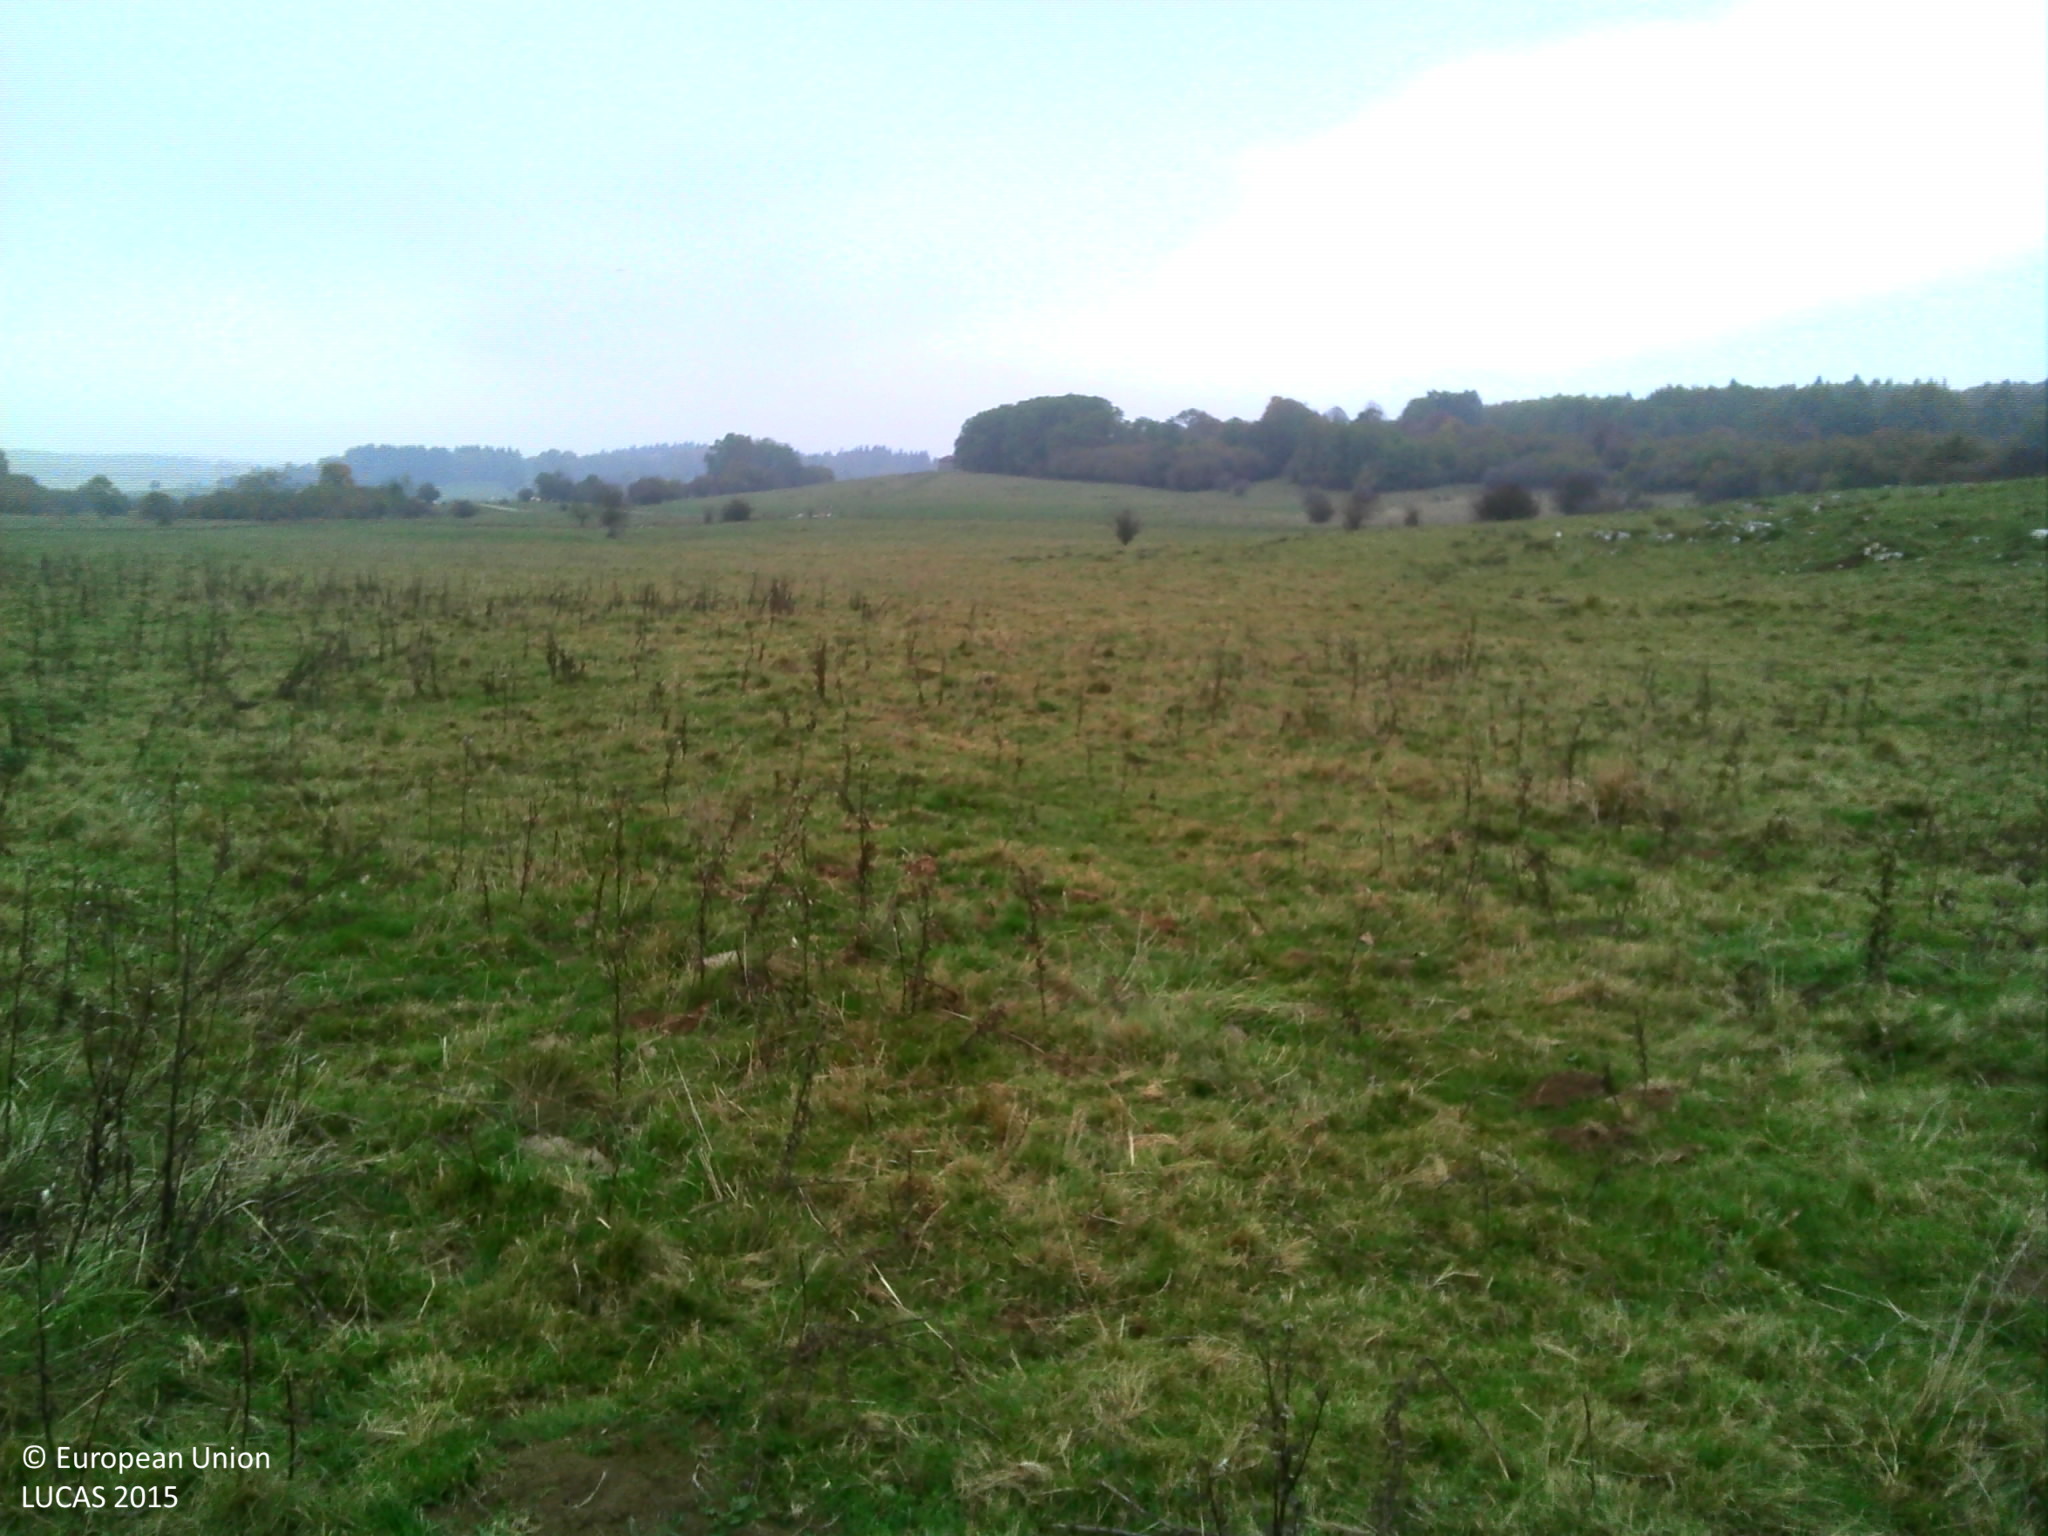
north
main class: Grassland
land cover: Grassland without tree/shrub cover
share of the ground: > 75 %
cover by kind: herbaceous plants 100 %
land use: Agriculture (excluding fallow land and kitchen gardens)
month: October
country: FR
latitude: 46.8772
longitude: 6.1579
